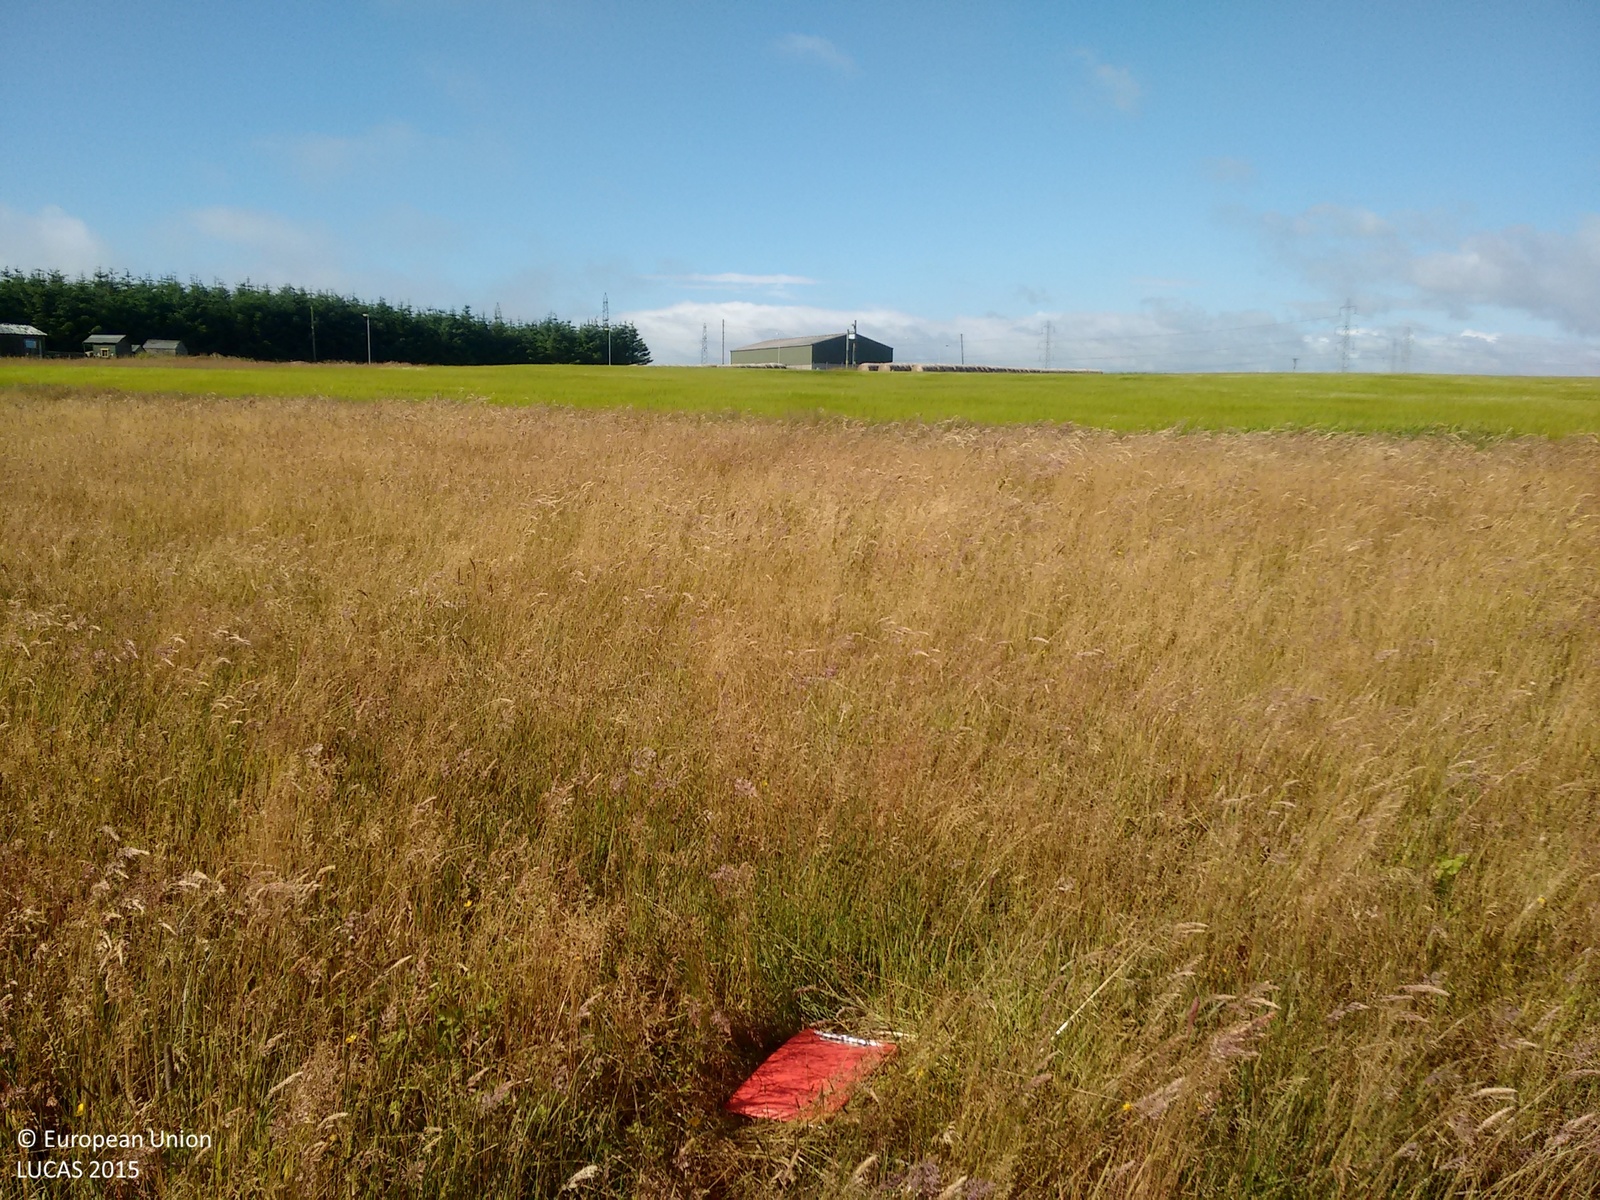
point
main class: Grassland
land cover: Grassland without tree/shrub cover
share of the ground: > 75 %
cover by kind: herbaceous plants 100 %
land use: Agriculture (excluding fallow land and kitchen gardens)
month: July
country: GB
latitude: 57.4791
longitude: -1.8000
